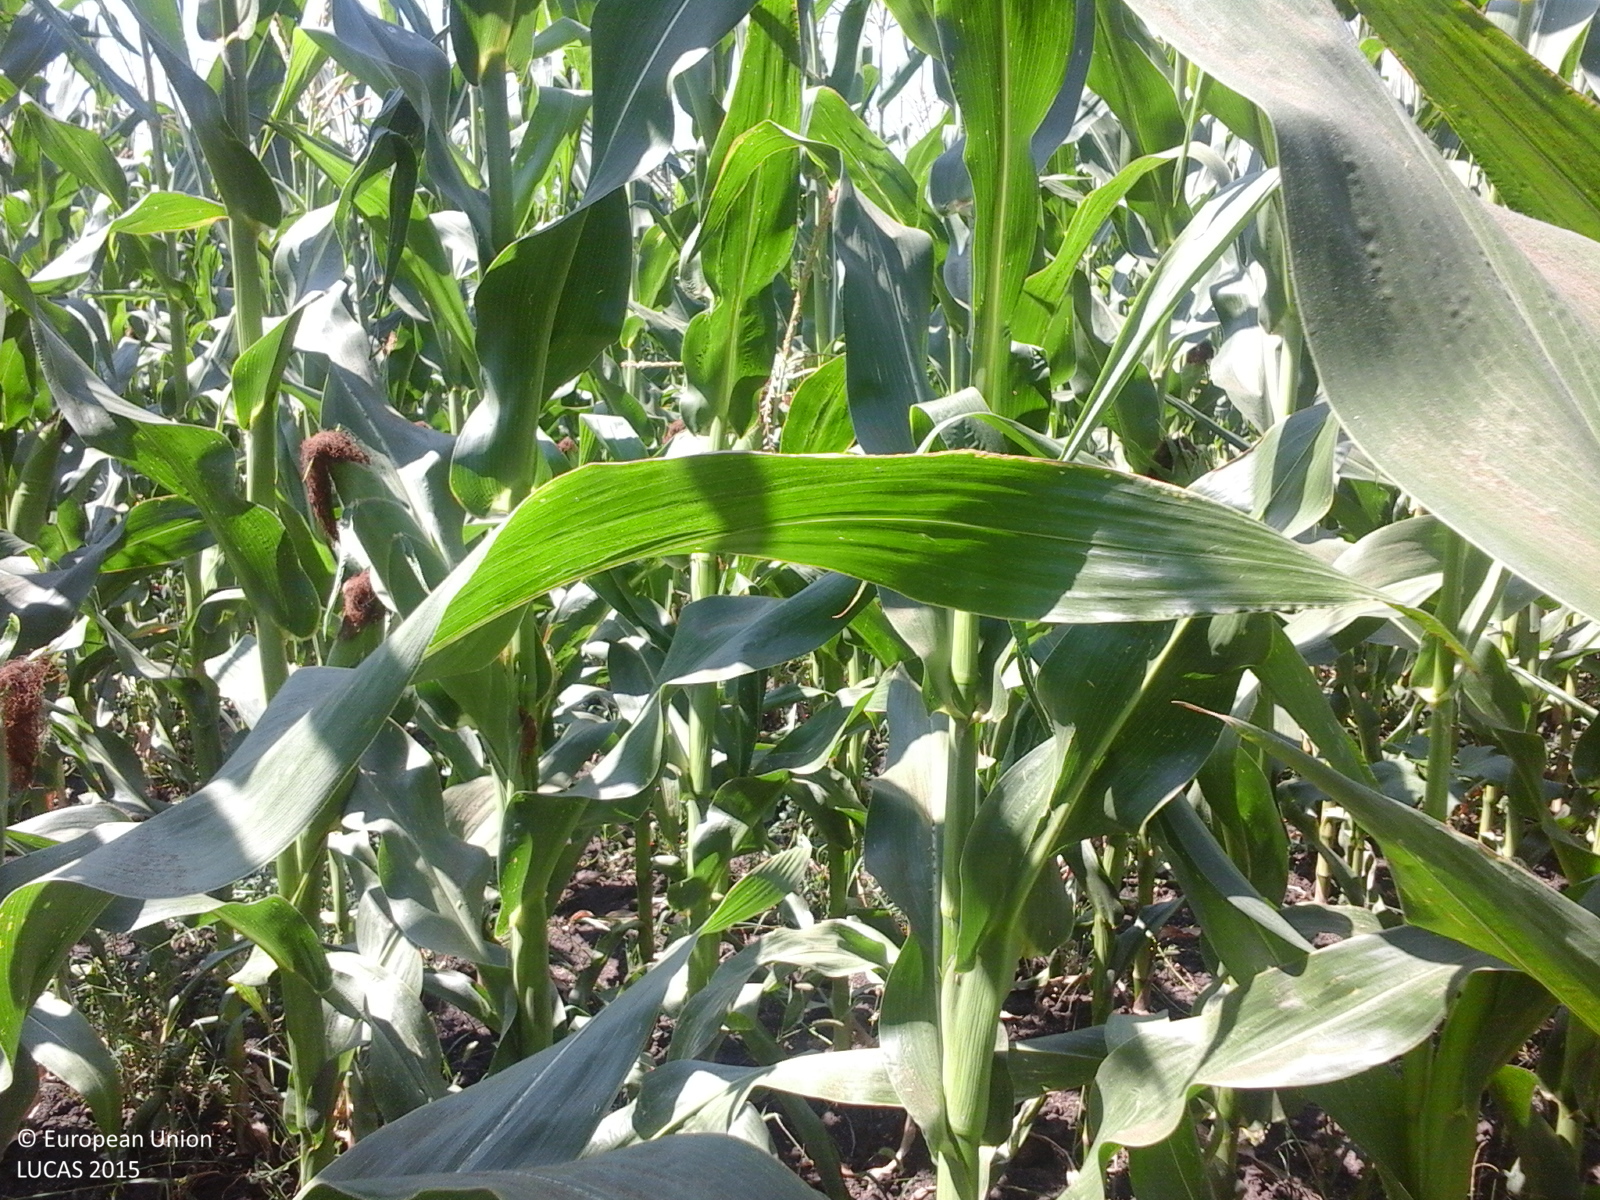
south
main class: Cropland
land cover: Maize
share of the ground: > 75 %
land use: Agriculture (excluding fallow land and kitchen gardens)
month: July
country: RO
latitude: 44.8864
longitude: 26.5419
